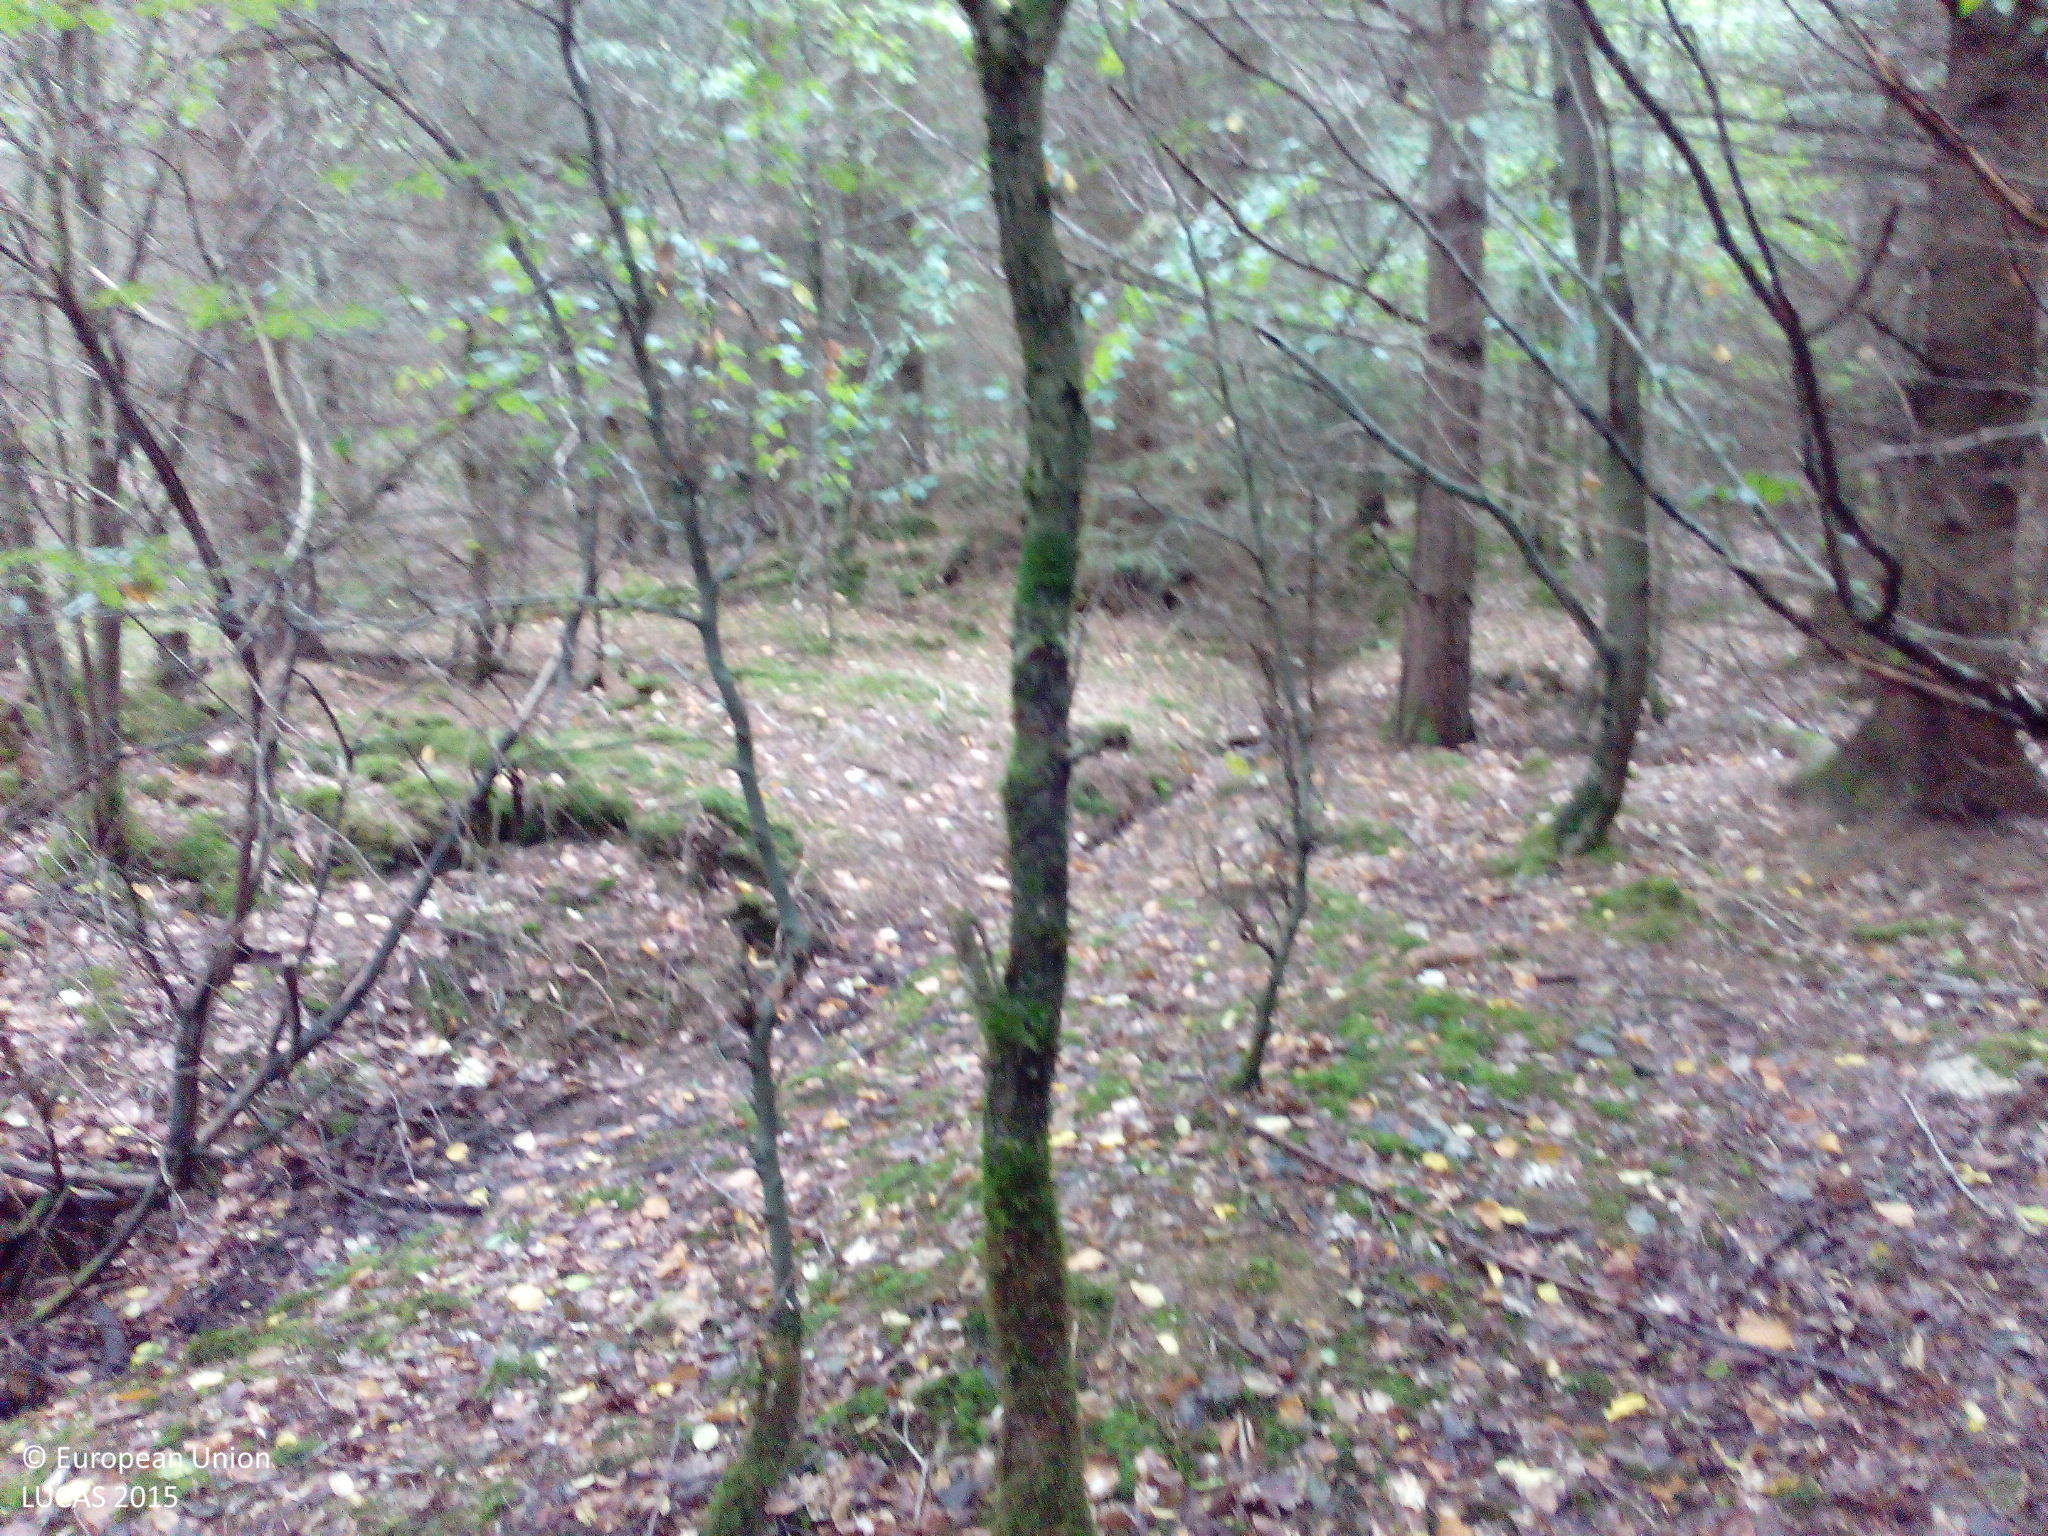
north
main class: Woodland
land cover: Spruce dominated mixed woodland
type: mesophytic deciduous forest
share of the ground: > 75 %
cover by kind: coniferous forest trees 45 %, broadleaved forest trees 45 %, unconsolidated bare surface 10 %
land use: Forestry
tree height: > 5 m
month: August
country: DE
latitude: 50.0687
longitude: 7.5833
